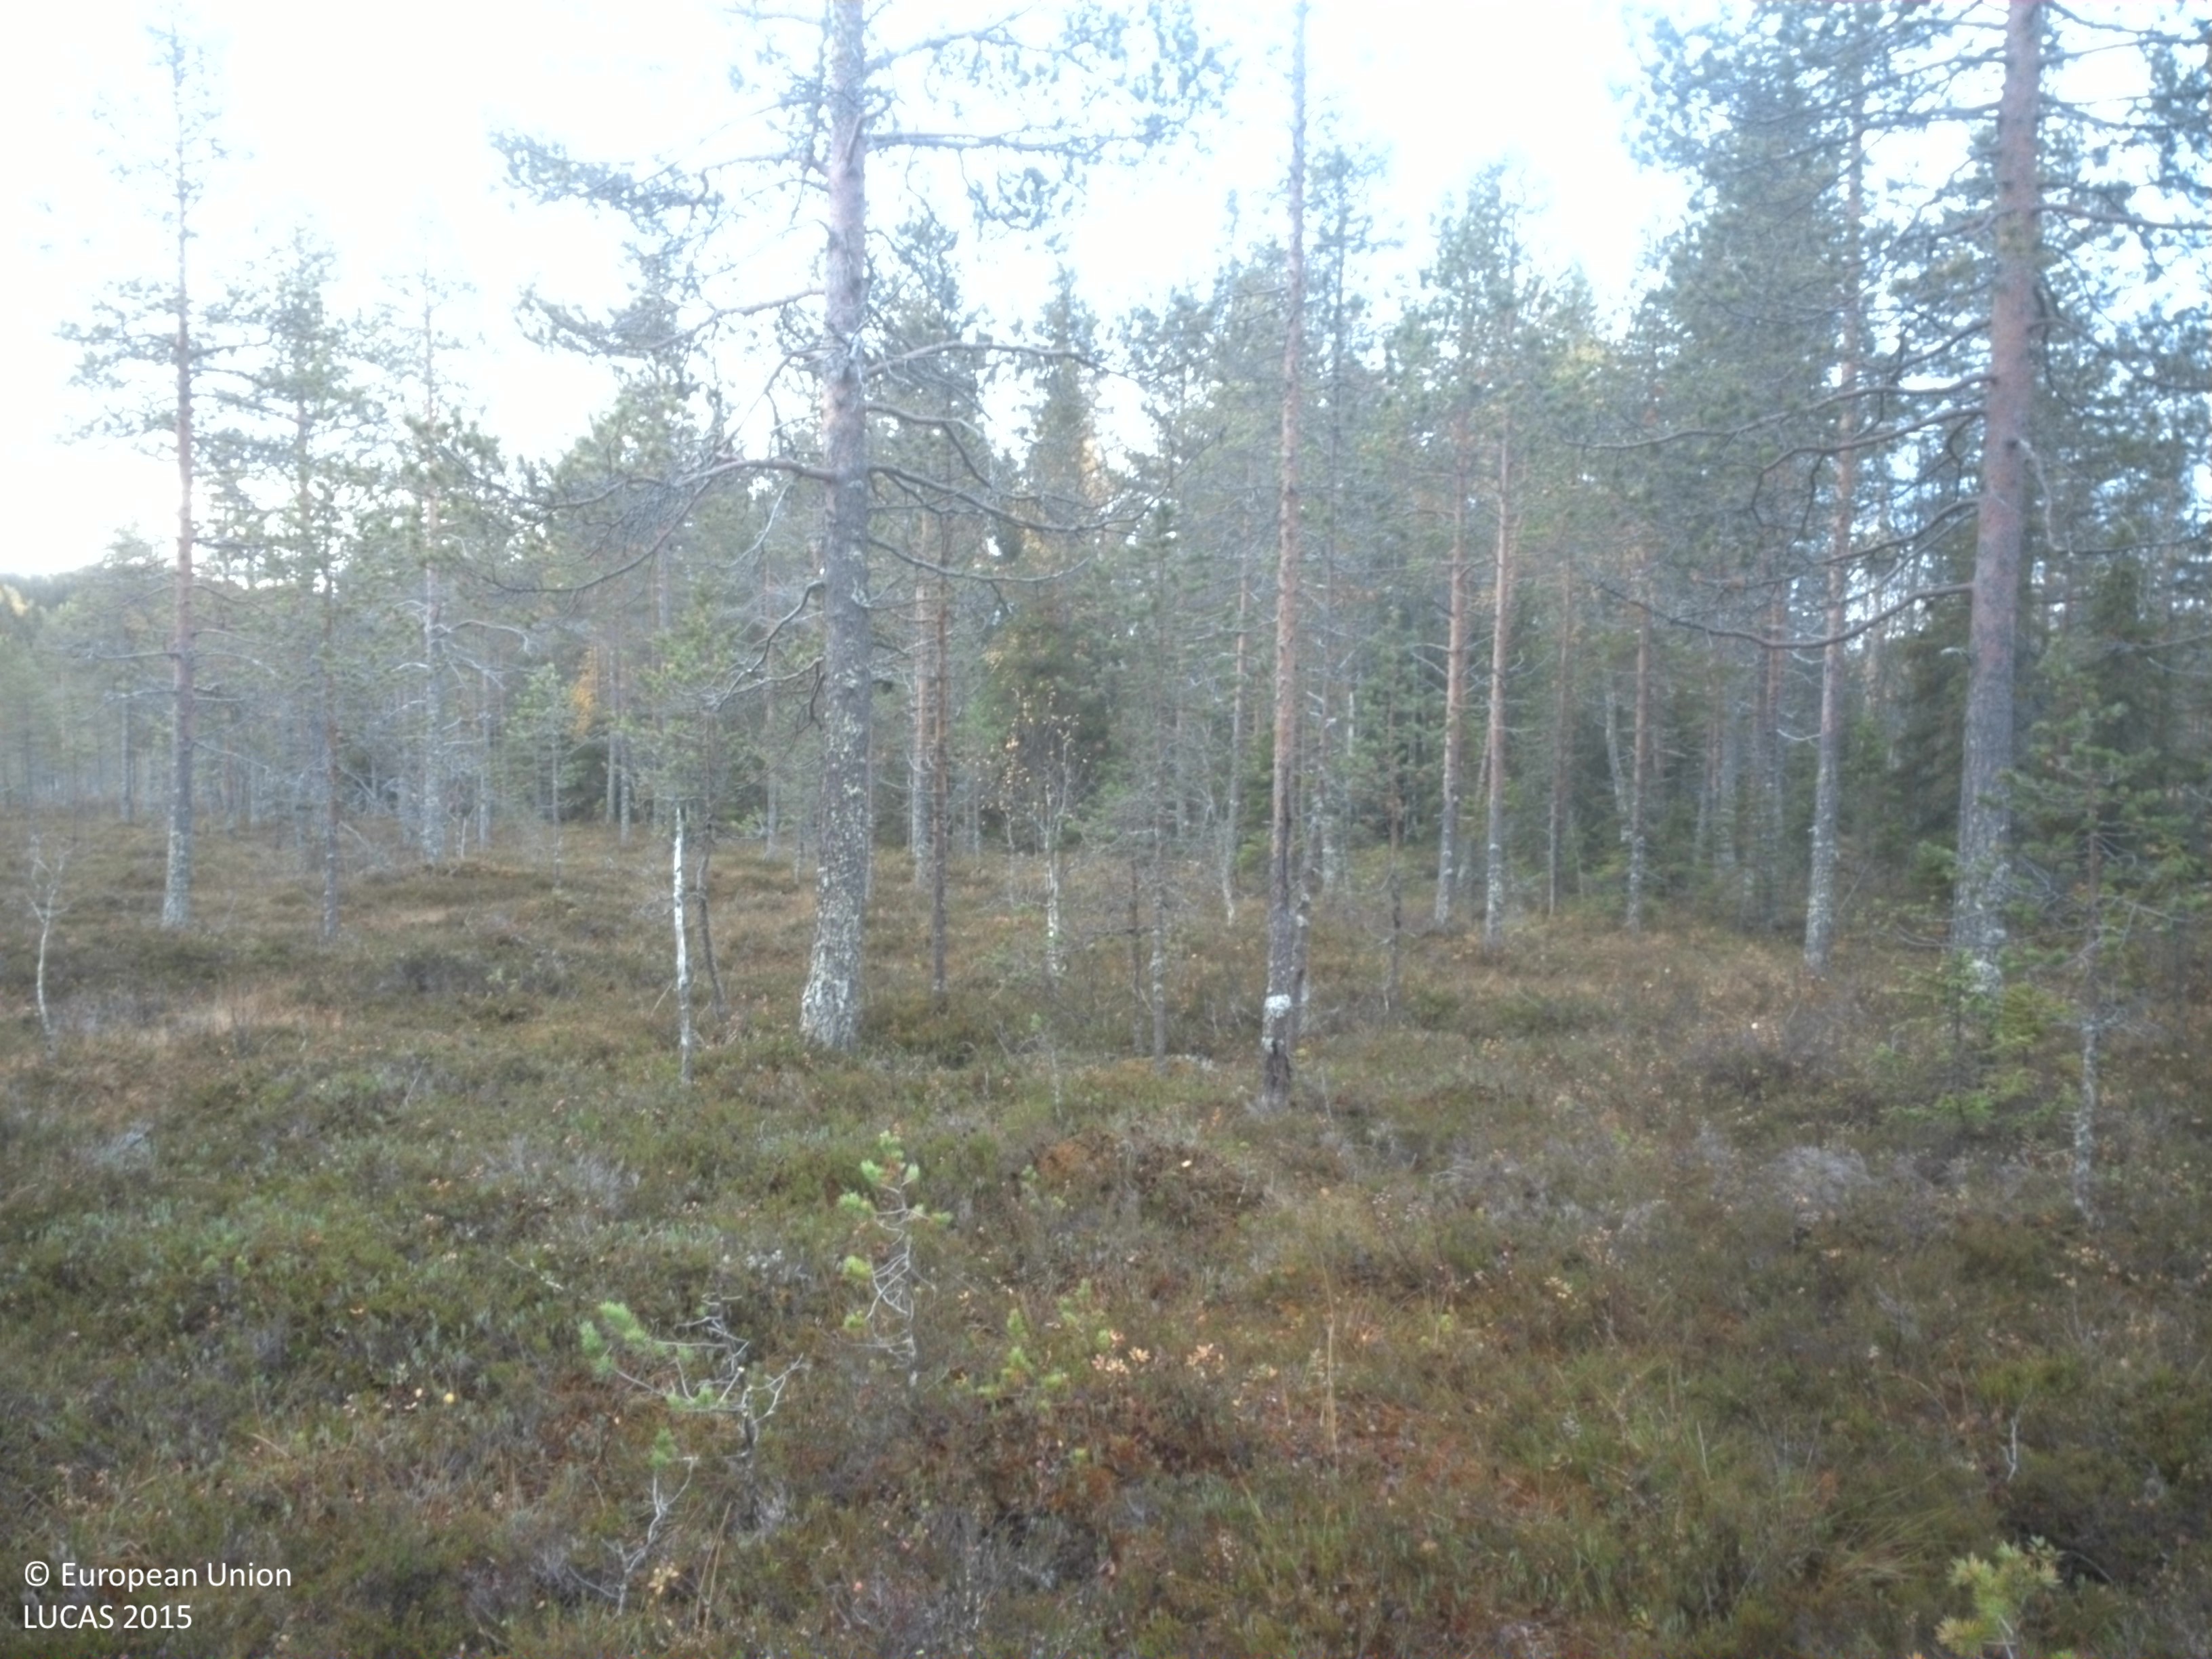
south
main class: Woodland
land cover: Pine dominated coniferous woodland
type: boreal forest
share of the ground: 25 - 50 %
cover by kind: coniferous forest trees 40 %, shrubs 30 %, lichens and mosses 25 %, herbaceous plants 5 %
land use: Semi-natural and natural areas not in use
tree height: > 5 m
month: September
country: SE
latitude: 64.2141
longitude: 19.9278
